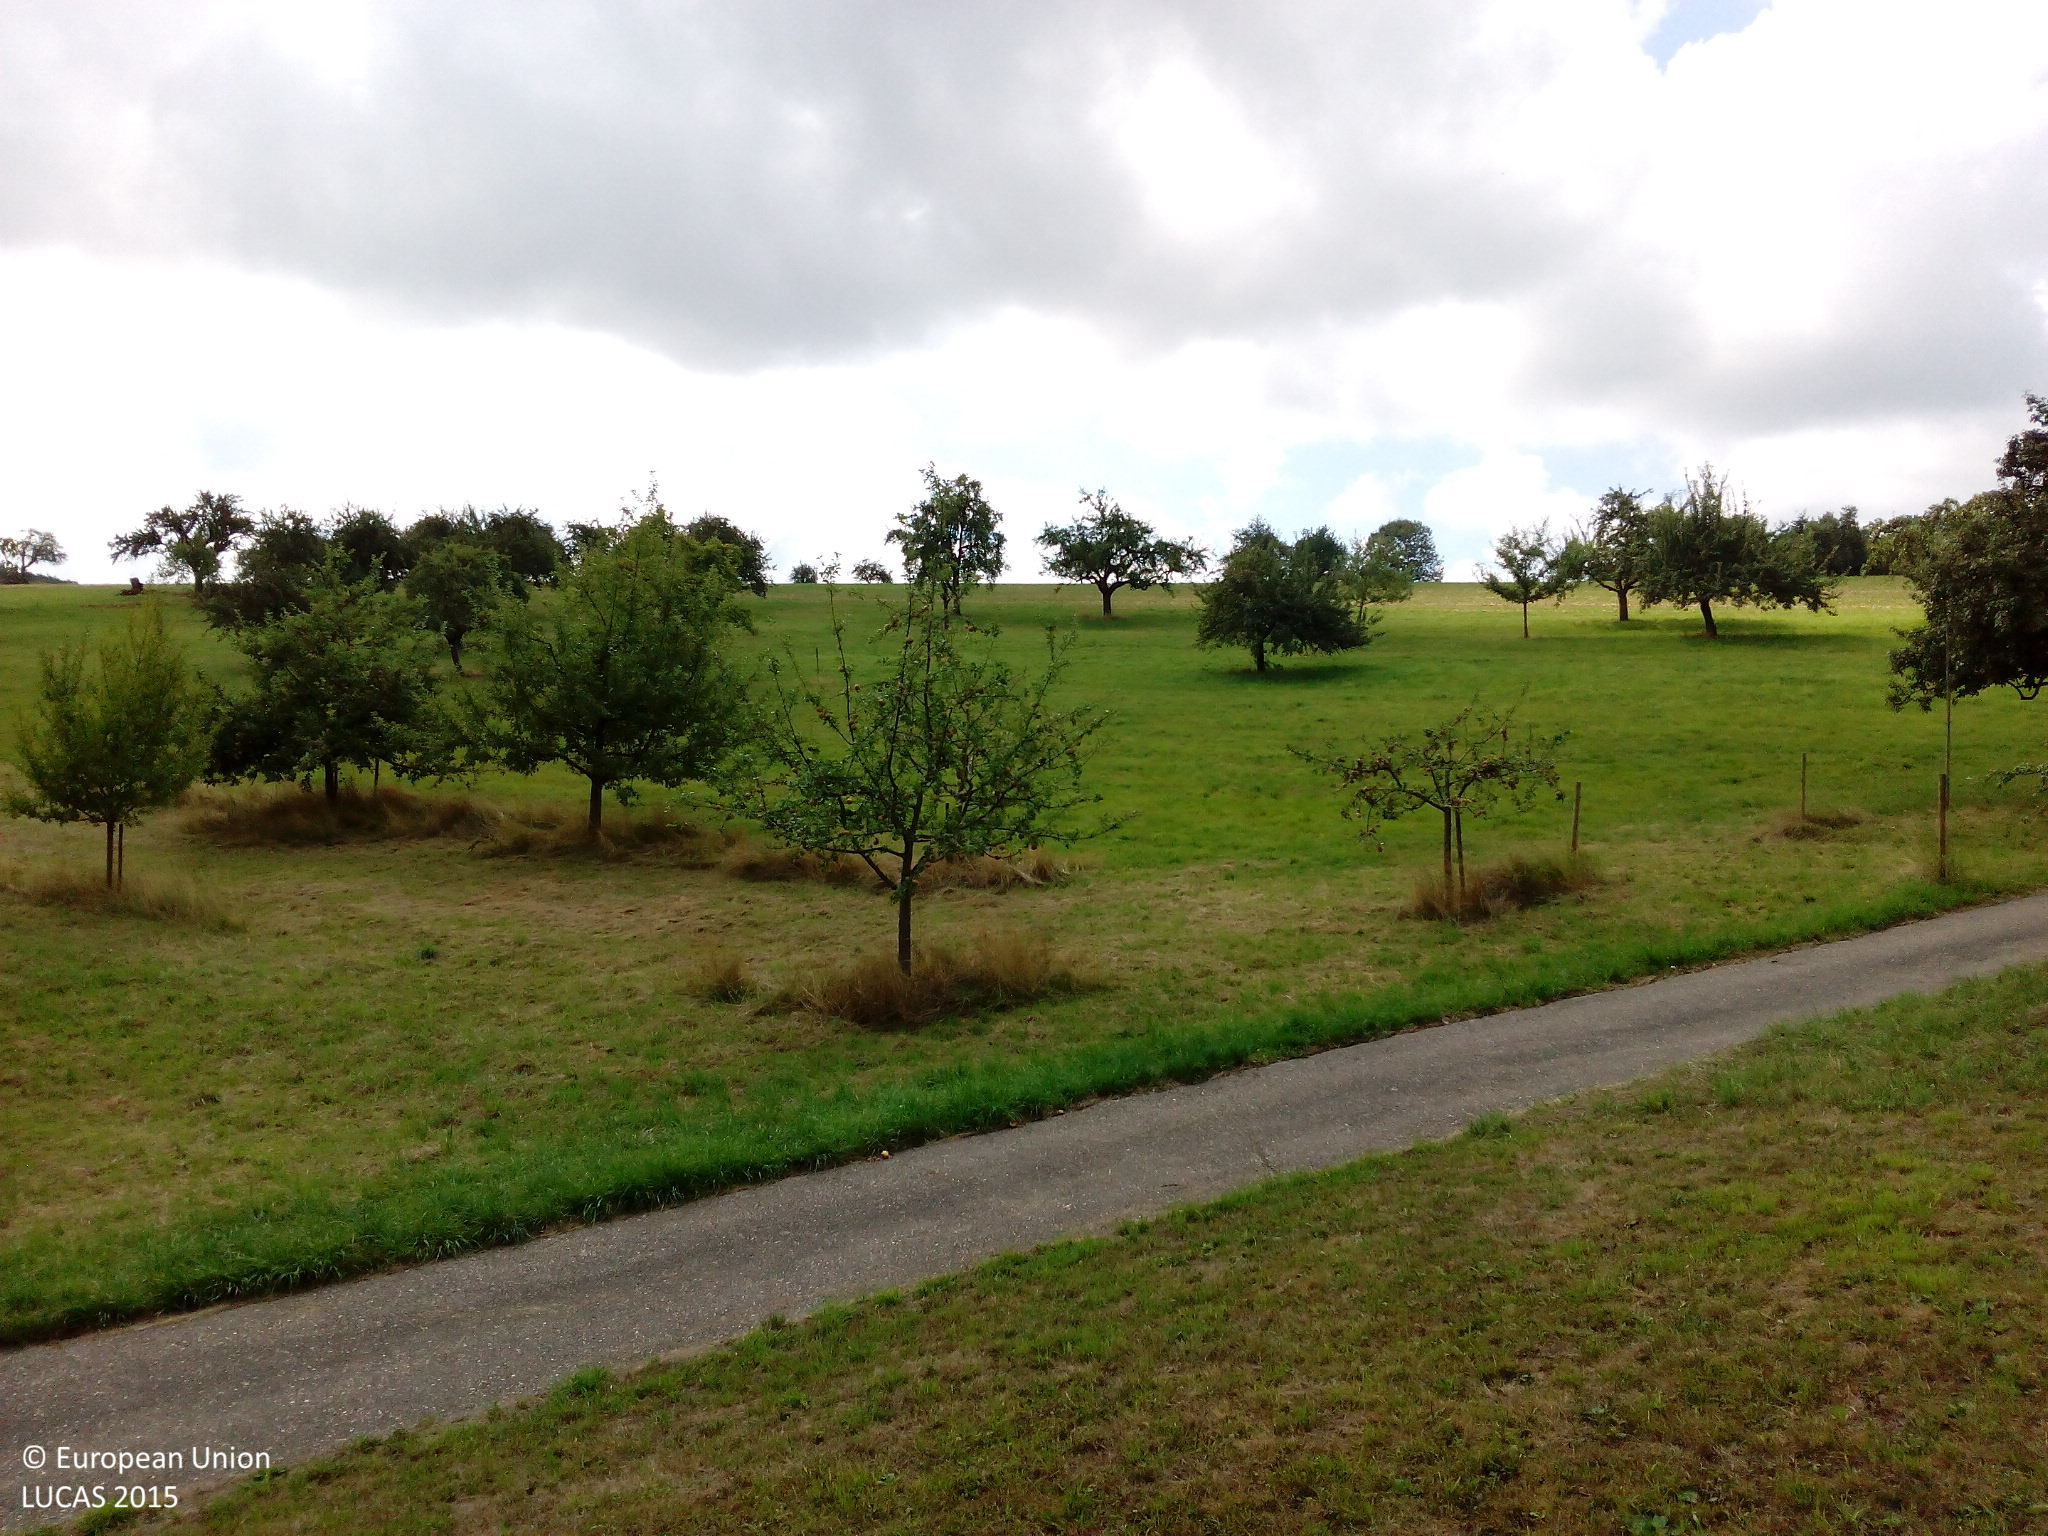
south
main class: Cropland
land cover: Apple fruit
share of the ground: 25 - 50 %
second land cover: Grassland without tree/shrub cover
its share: > 75 %
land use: Agriculture (excluding fallow land and kitchen gardens)
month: August
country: DE
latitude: 48.9534
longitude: 8.6759
